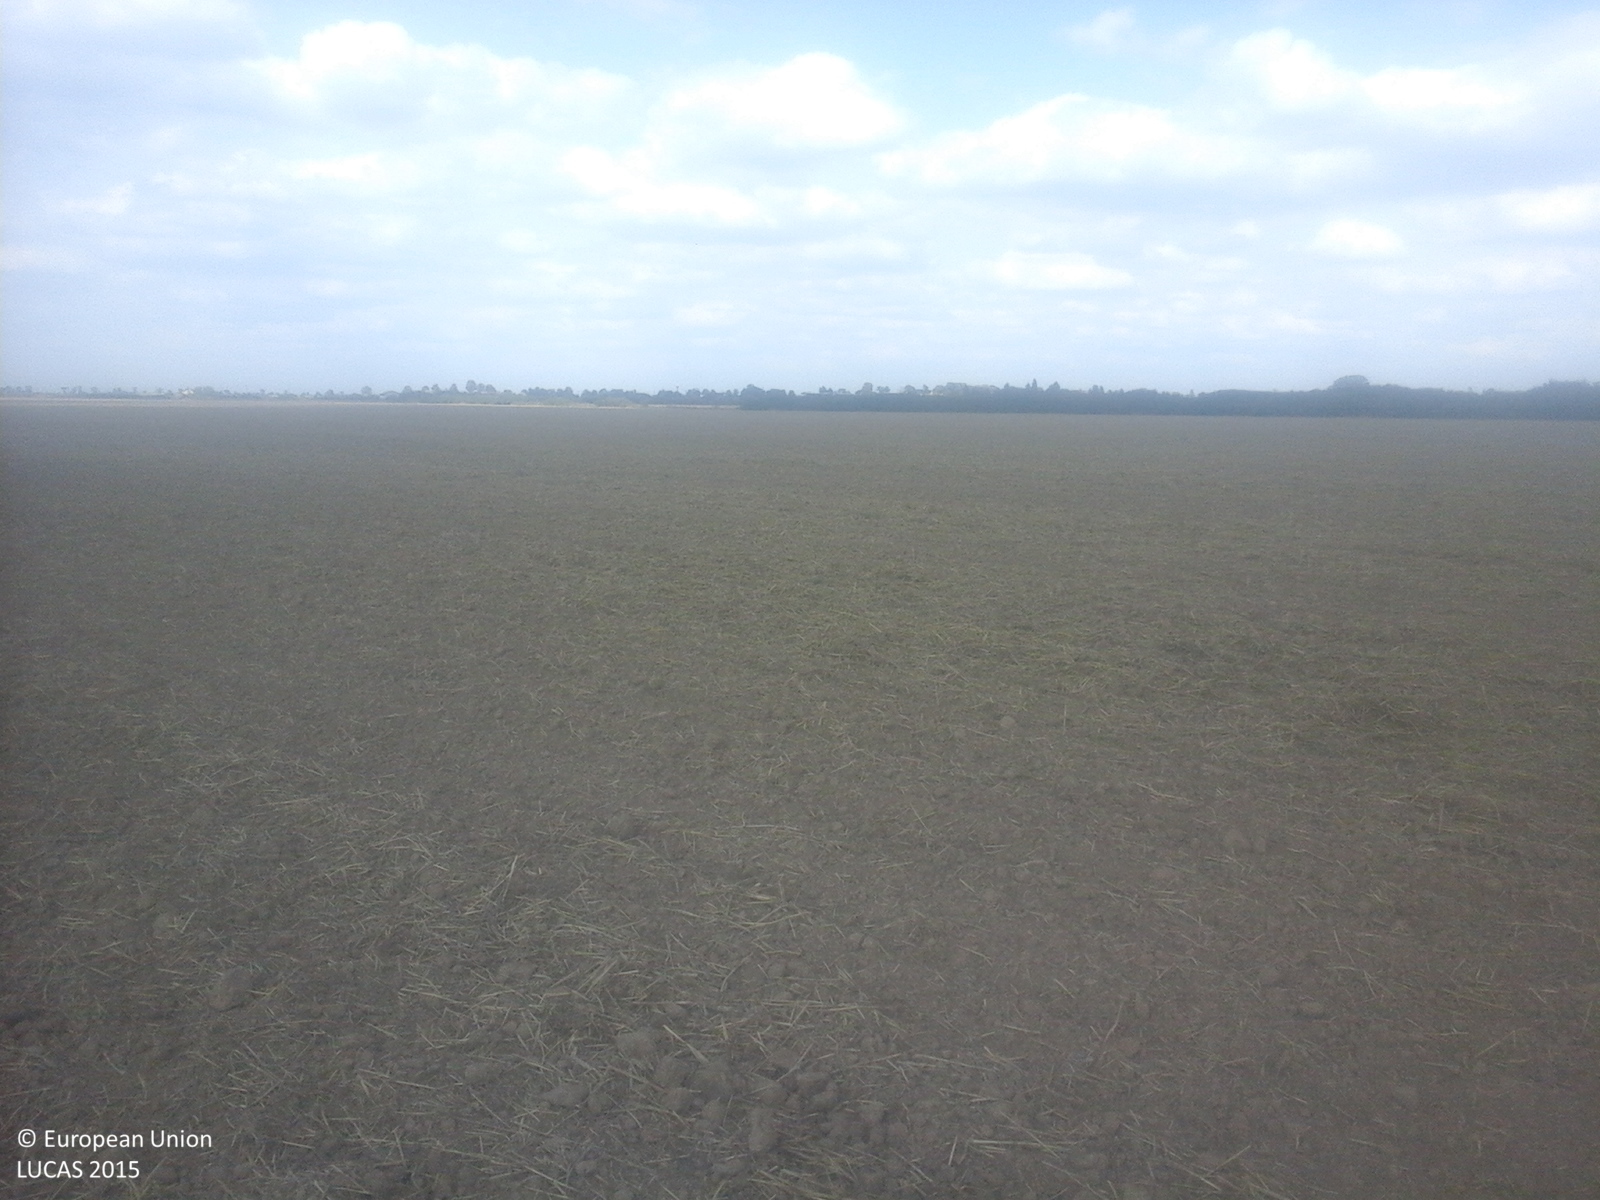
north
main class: Cropland
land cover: Common wheat
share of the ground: < 10 %
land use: Agriculture (excluding fallow land and kitchen gardens)
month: September
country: RO
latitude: 47.6885
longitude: 22.6775
